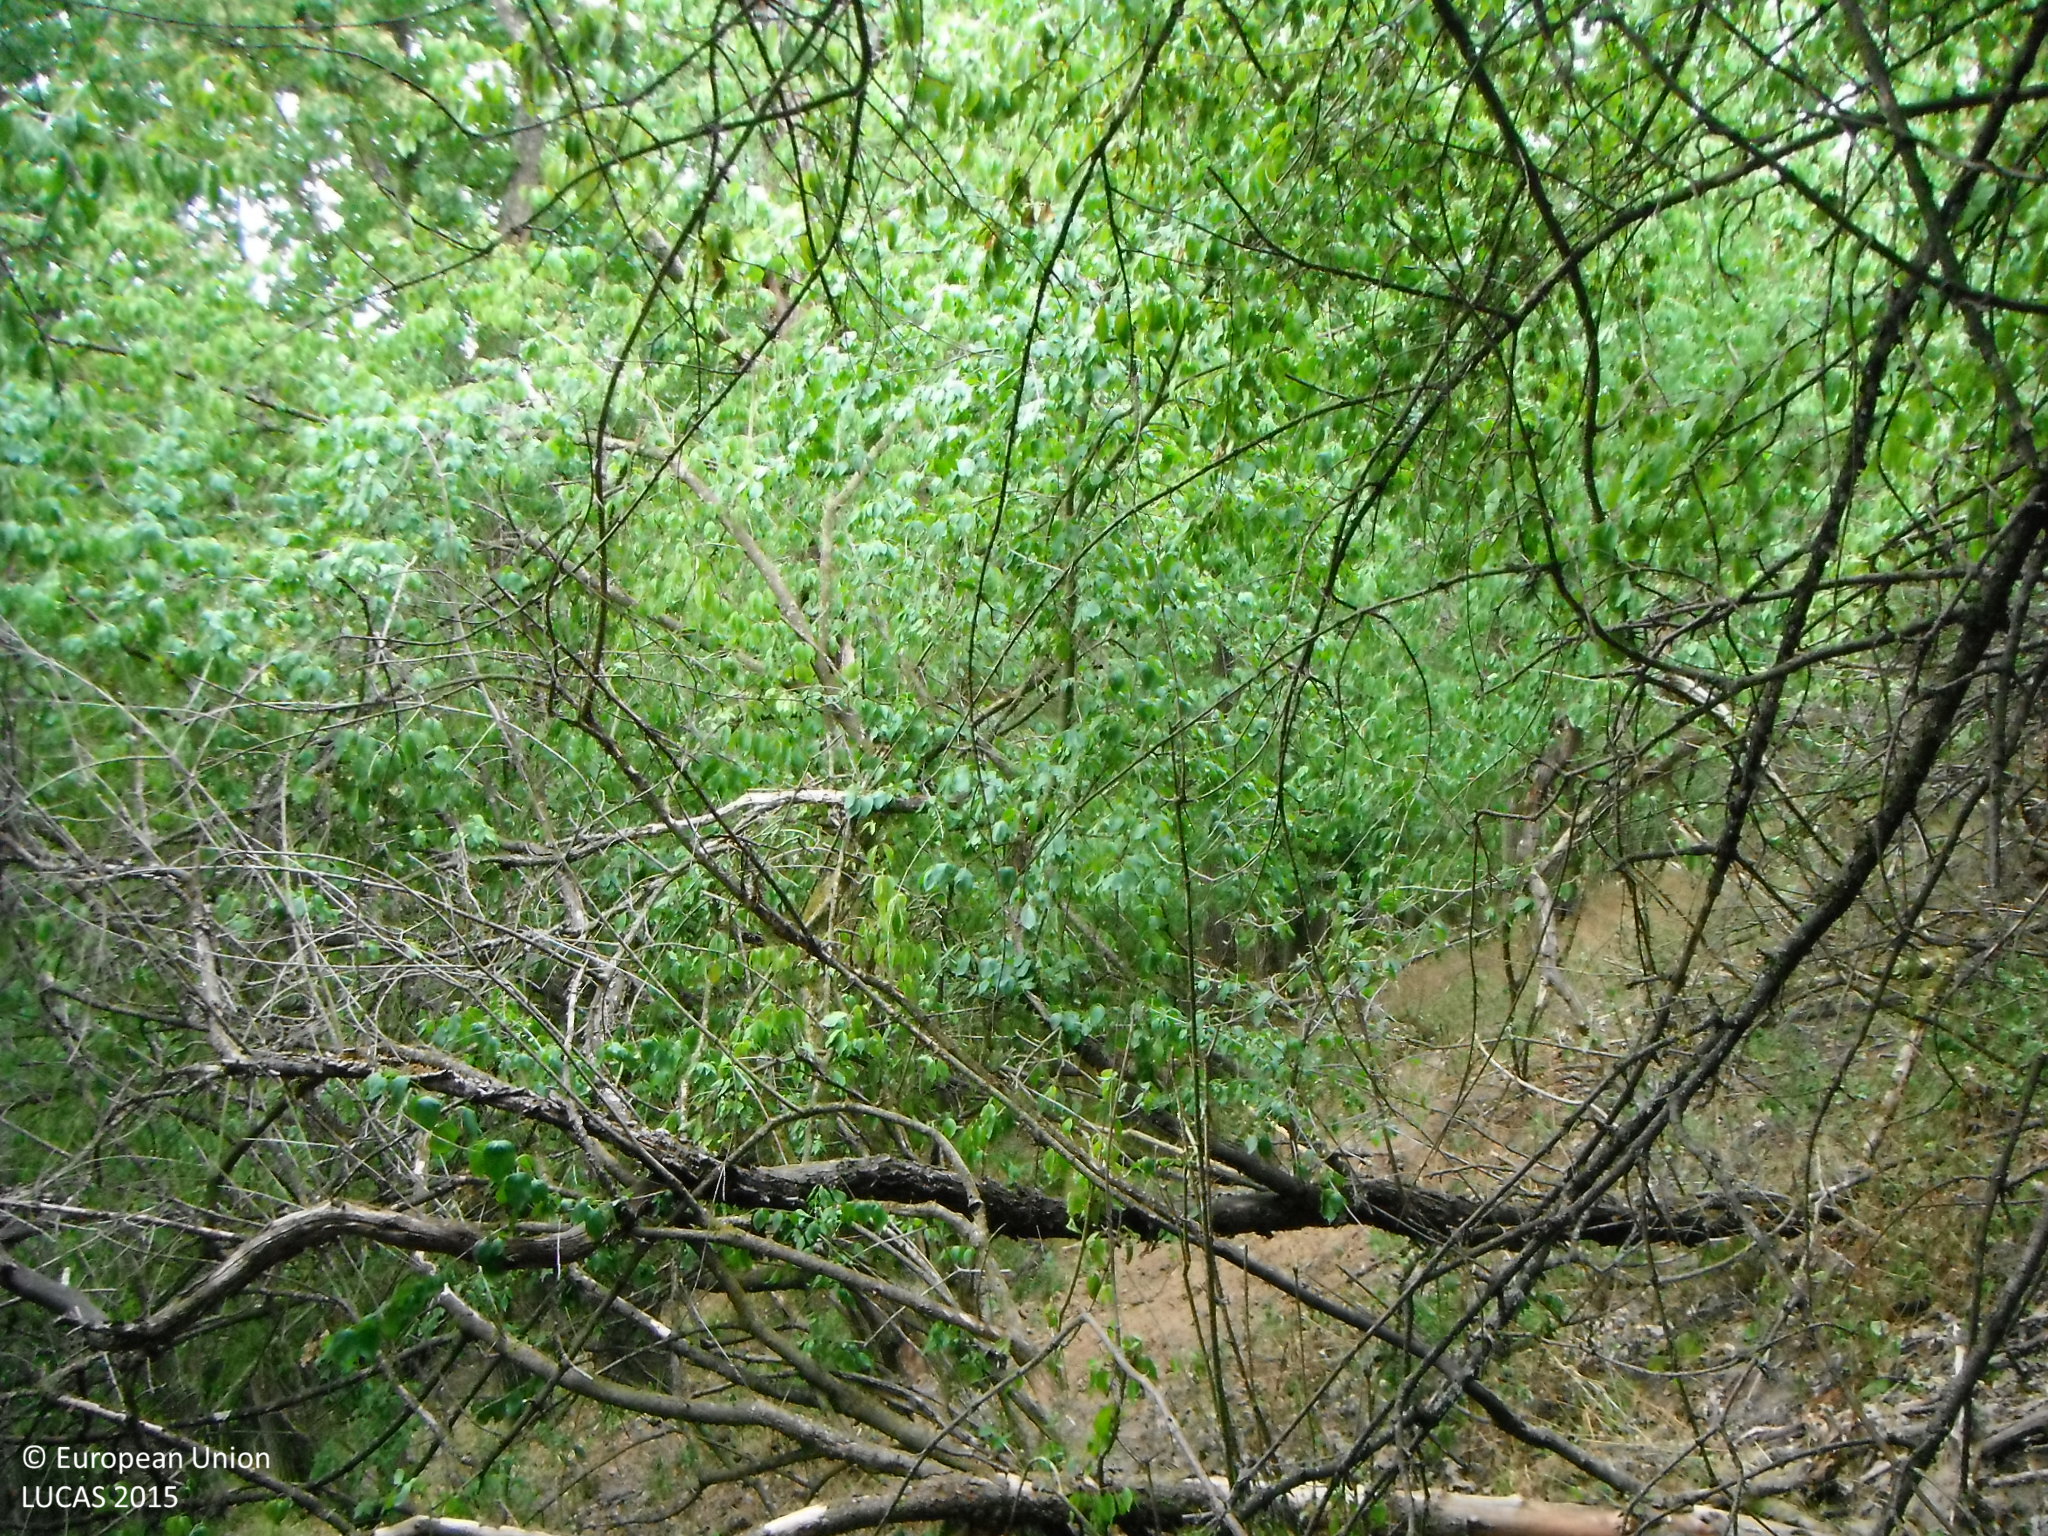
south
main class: Woodland
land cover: Broadleaved woodland
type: mesophytic deciduous forest
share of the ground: > 75 %
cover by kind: broadleaved forest trees 100 %
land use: Forestry
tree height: > 5 m
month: July
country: SK
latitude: 48.2841
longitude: 19.0633
